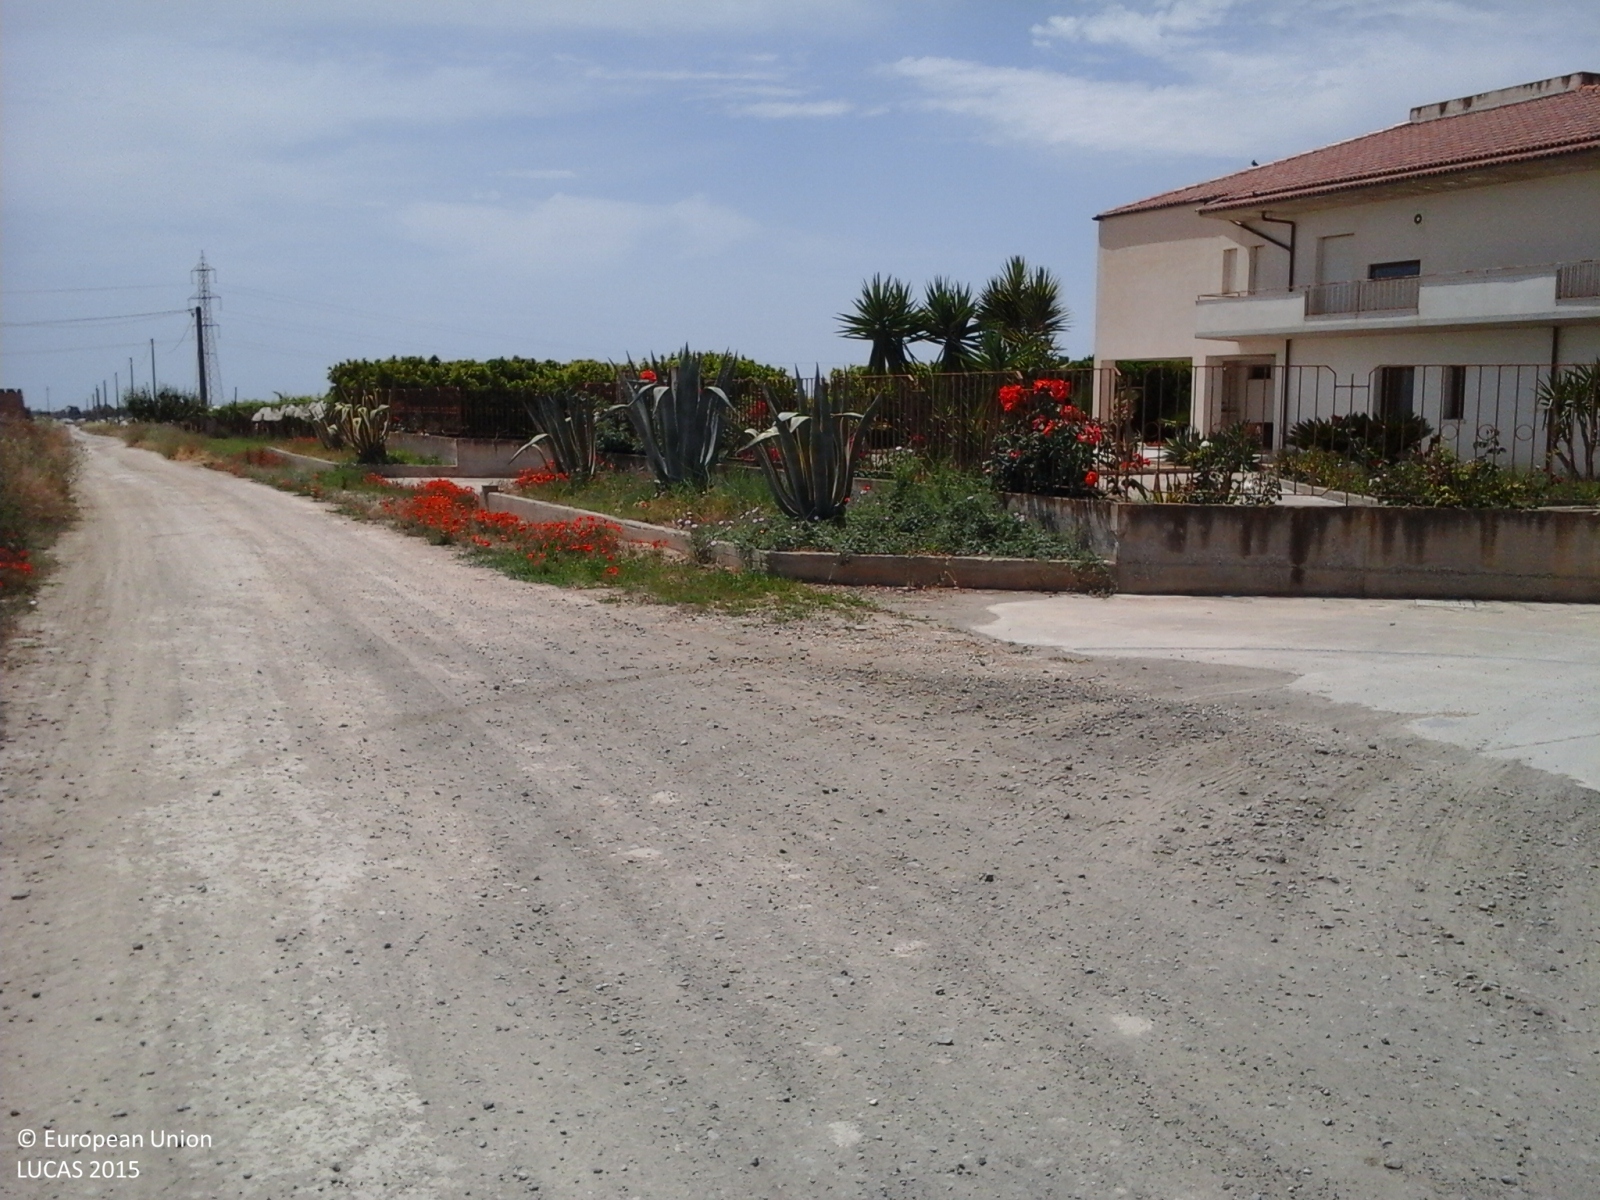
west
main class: Cropland
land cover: Vineyards
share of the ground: 25 - 50 %
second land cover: Spontaneously vegetated surfaces
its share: > 75 %
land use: Agriculture (excluding fallow land and kitchen gardens)
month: May
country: IT
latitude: 37.1104
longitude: 14.5671
